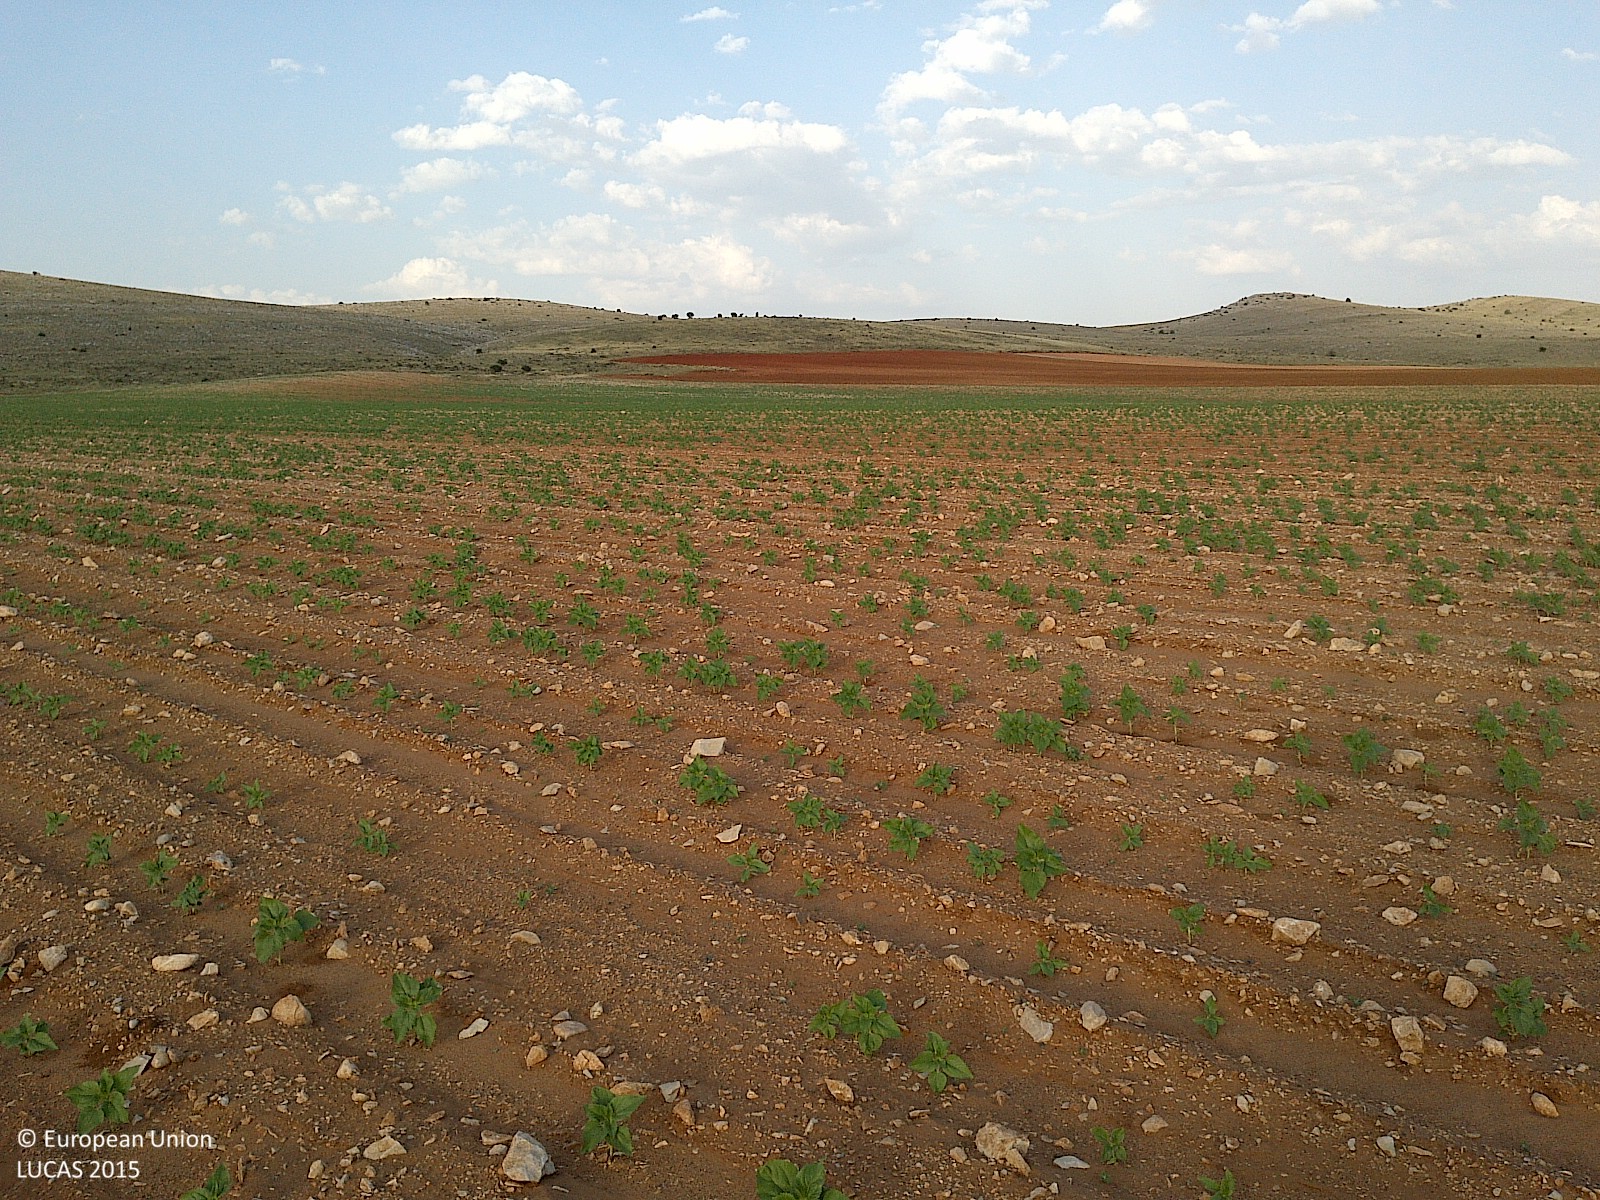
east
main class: Cropland
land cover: Sunflower
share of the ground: < 10 %
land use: Agriculture (excluding fallow land and kitchen gardens)
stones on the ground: < 10 %
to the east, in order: Sunflower
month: June
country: ES
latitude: 41.6463
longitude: -2.1478
